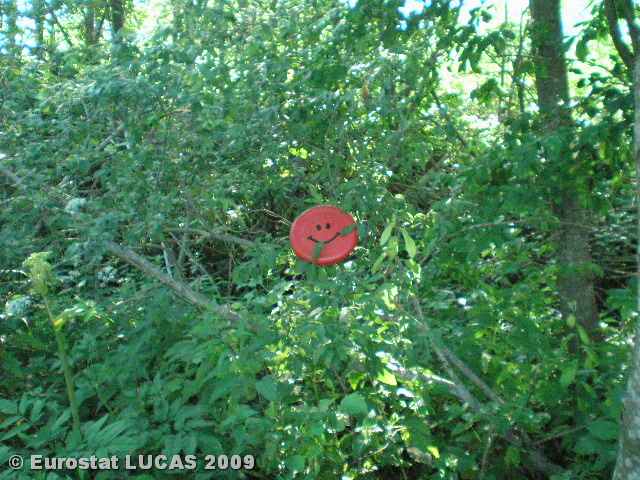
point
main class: Woodland
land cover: Broadleaved woodland
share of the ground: > 75 %
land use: Agriculture (excluding fallow land and kitchen gardens)
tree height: > 5 m
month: July
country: LT
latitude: 54.9609
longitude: 25.5100
